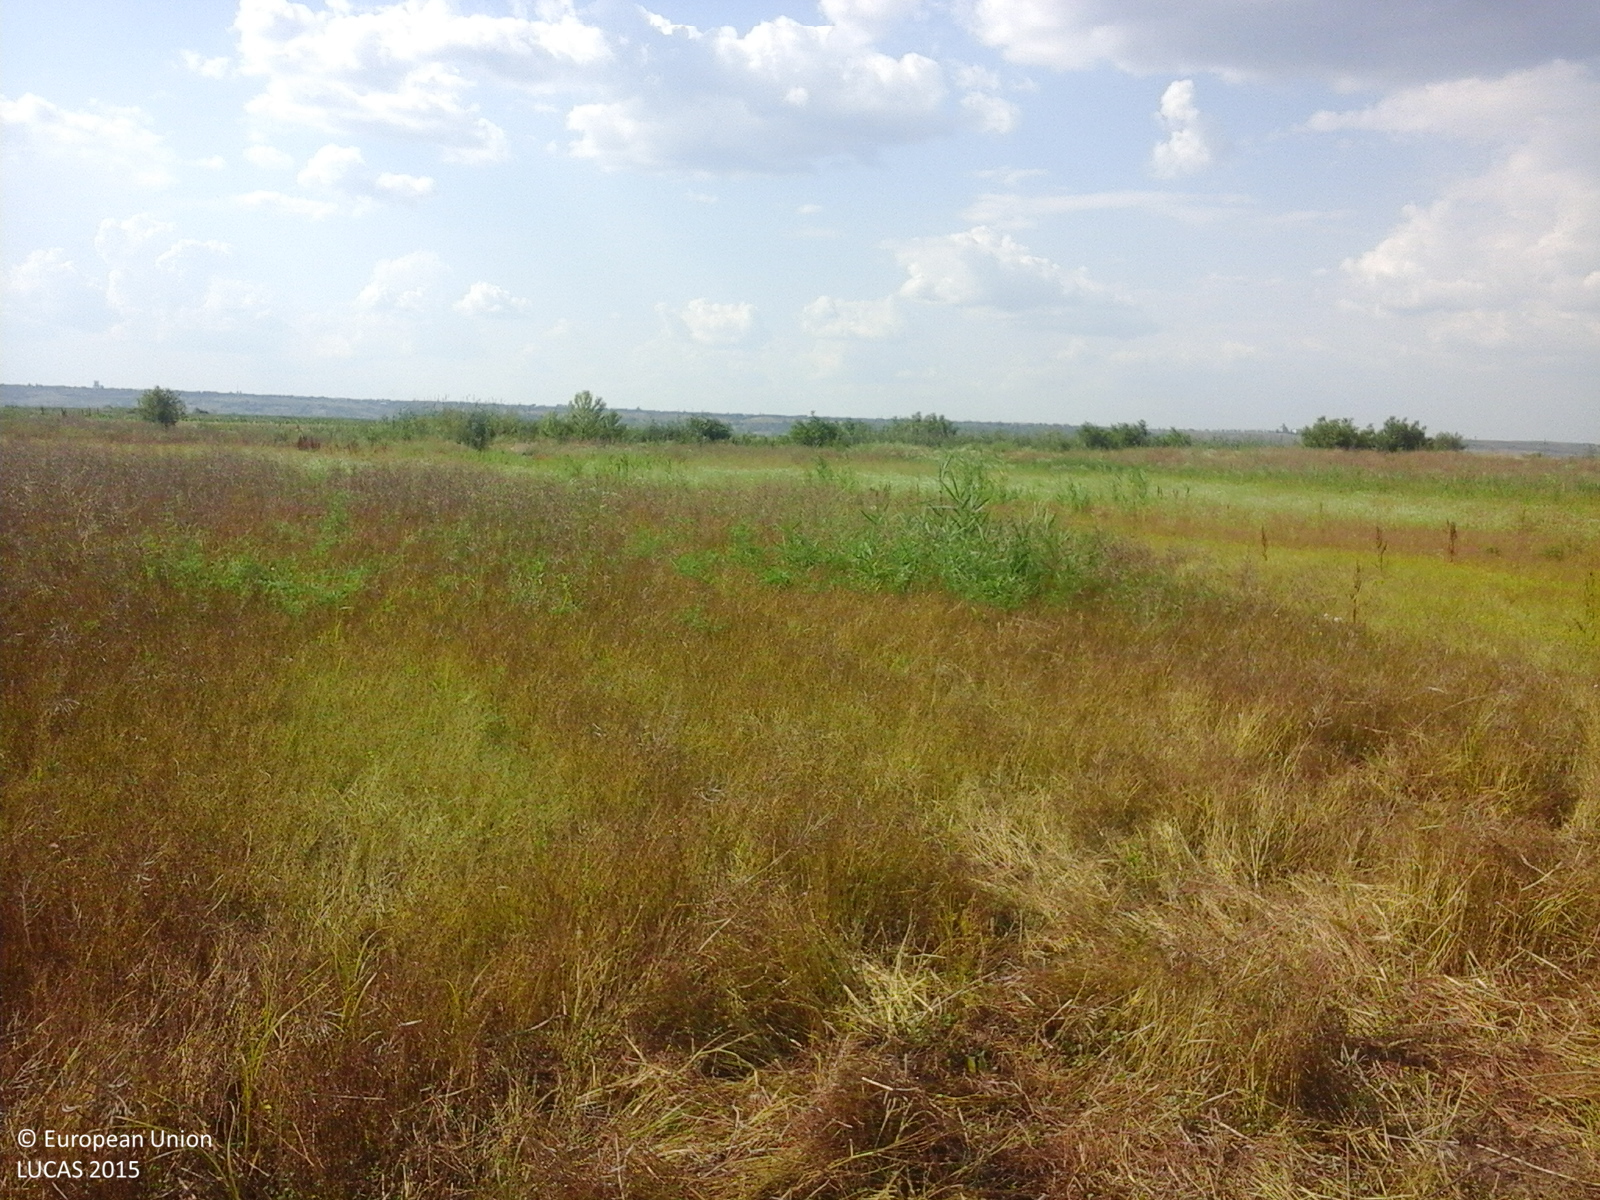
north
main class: Grassland
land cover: Spontaneously vegetated surfaces
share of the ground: > 75 %
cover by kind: herbaceous plants 100 %
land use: Fallow land
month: July
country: RO
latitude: 44.0014
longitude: 26.1011
